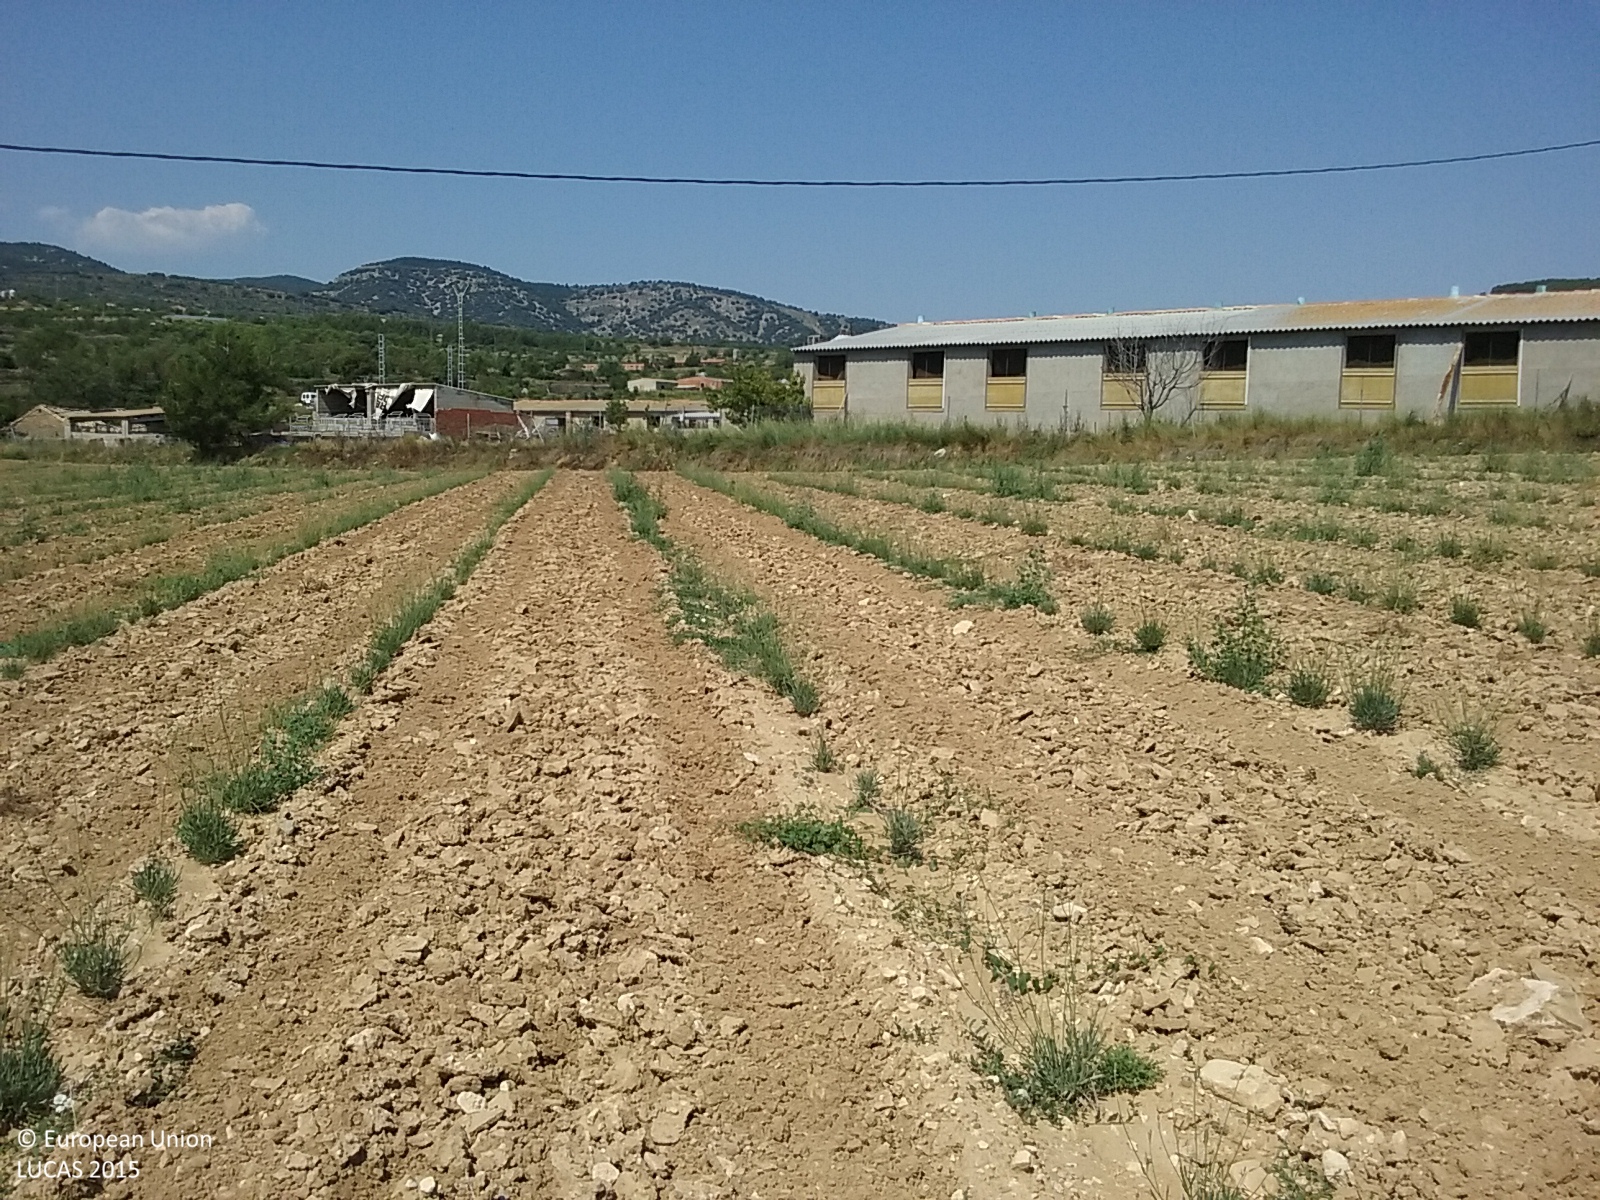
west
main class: Cropland
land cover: Permanent industrial crops
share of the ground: < 10 %
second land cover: Other bare soil
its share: > 75 %
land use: Agriculture (excluding fallow land and kitchen gardens)
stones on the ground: 10 - 25 %
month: June
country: ES
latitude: 40.5902
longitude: -0.2044
